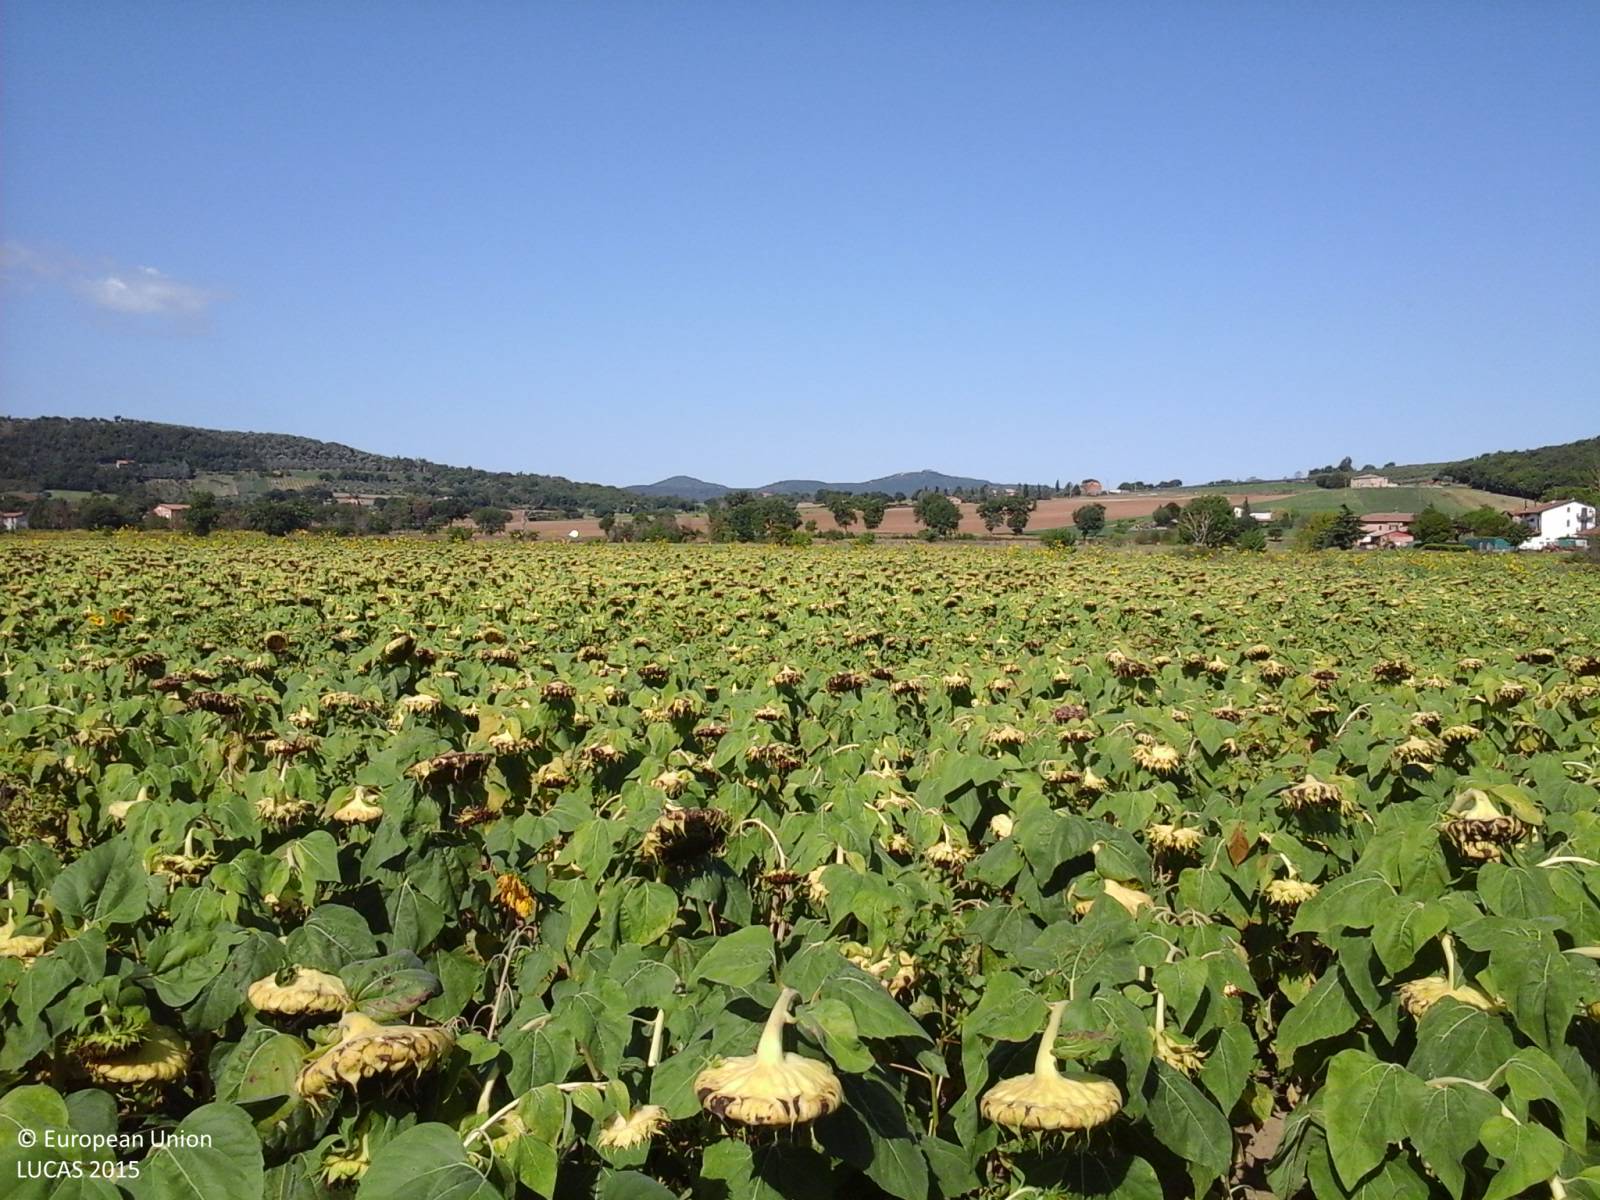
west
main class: Cropland
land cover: Sunflower
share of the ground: > 75 %
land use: Agriculture (excluding fallow land and kitchen gardens)
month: September
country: IT
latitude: 43.0262
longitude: 12.2636
